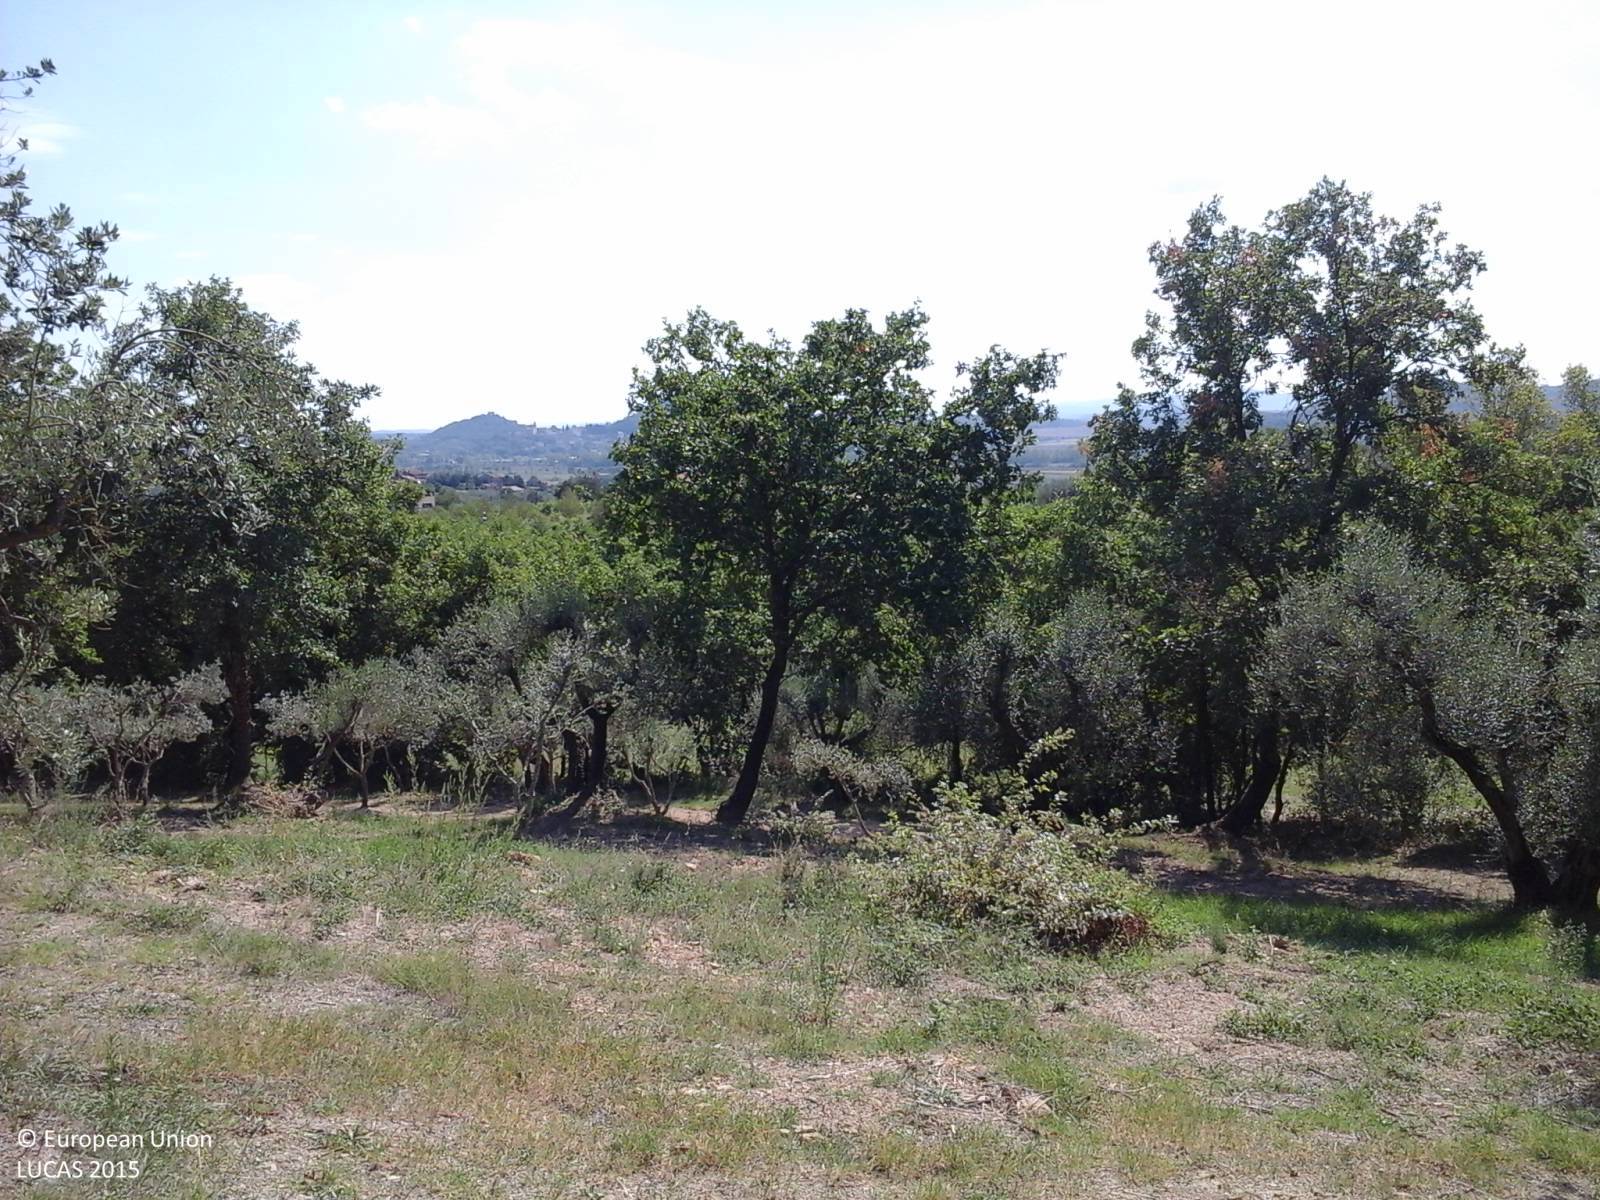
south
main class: Cropland
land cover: Olive groves
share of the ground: 25 - 50 %
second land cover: Grassland without tree/shrub cover
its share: > 75 %
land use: Agriculture (excluding fallow land and kitchen gardens)
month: September
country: IT
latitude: 43.1164
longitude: 12.2670
